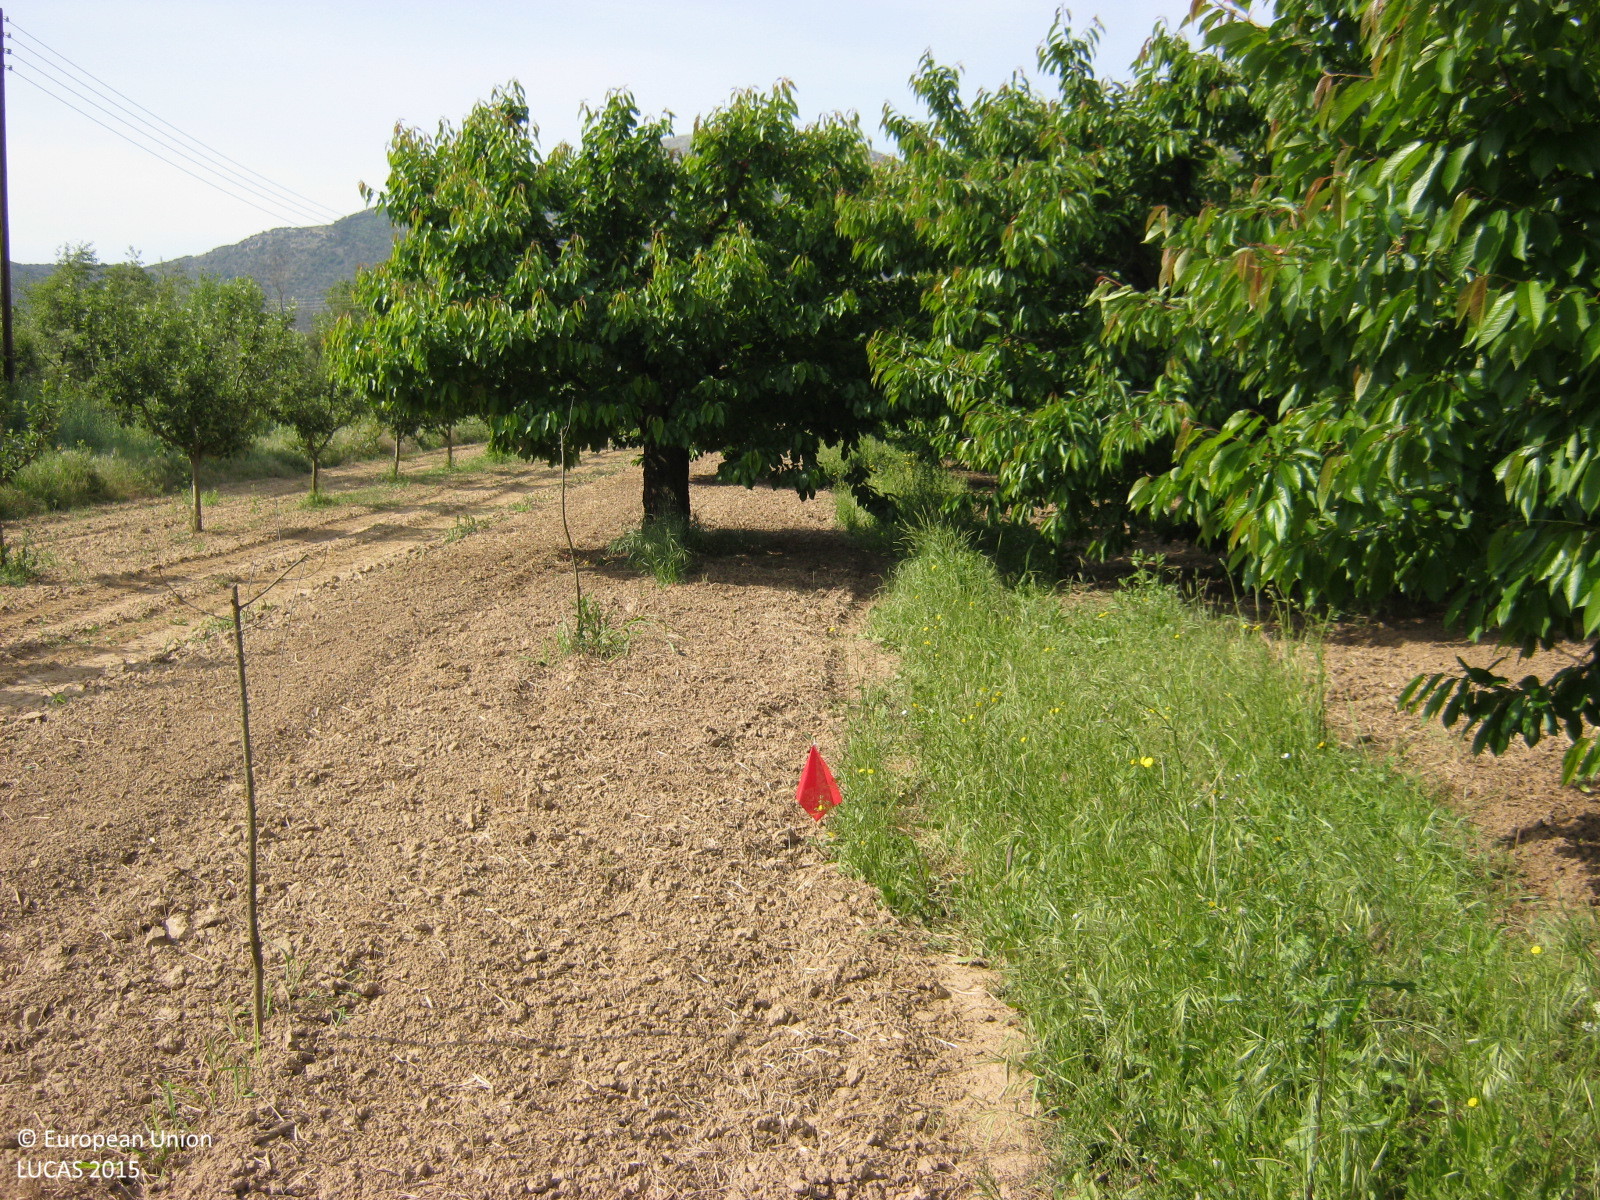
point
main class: Cropland
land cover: Cherry fruit
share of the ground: 25 - 50 %
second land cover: Other bare soil
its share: > 75 %
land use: Agriculture (excluding fallow land and kitchen gardens)
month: June
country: GR
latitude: 37.4868
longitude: 22.5047
